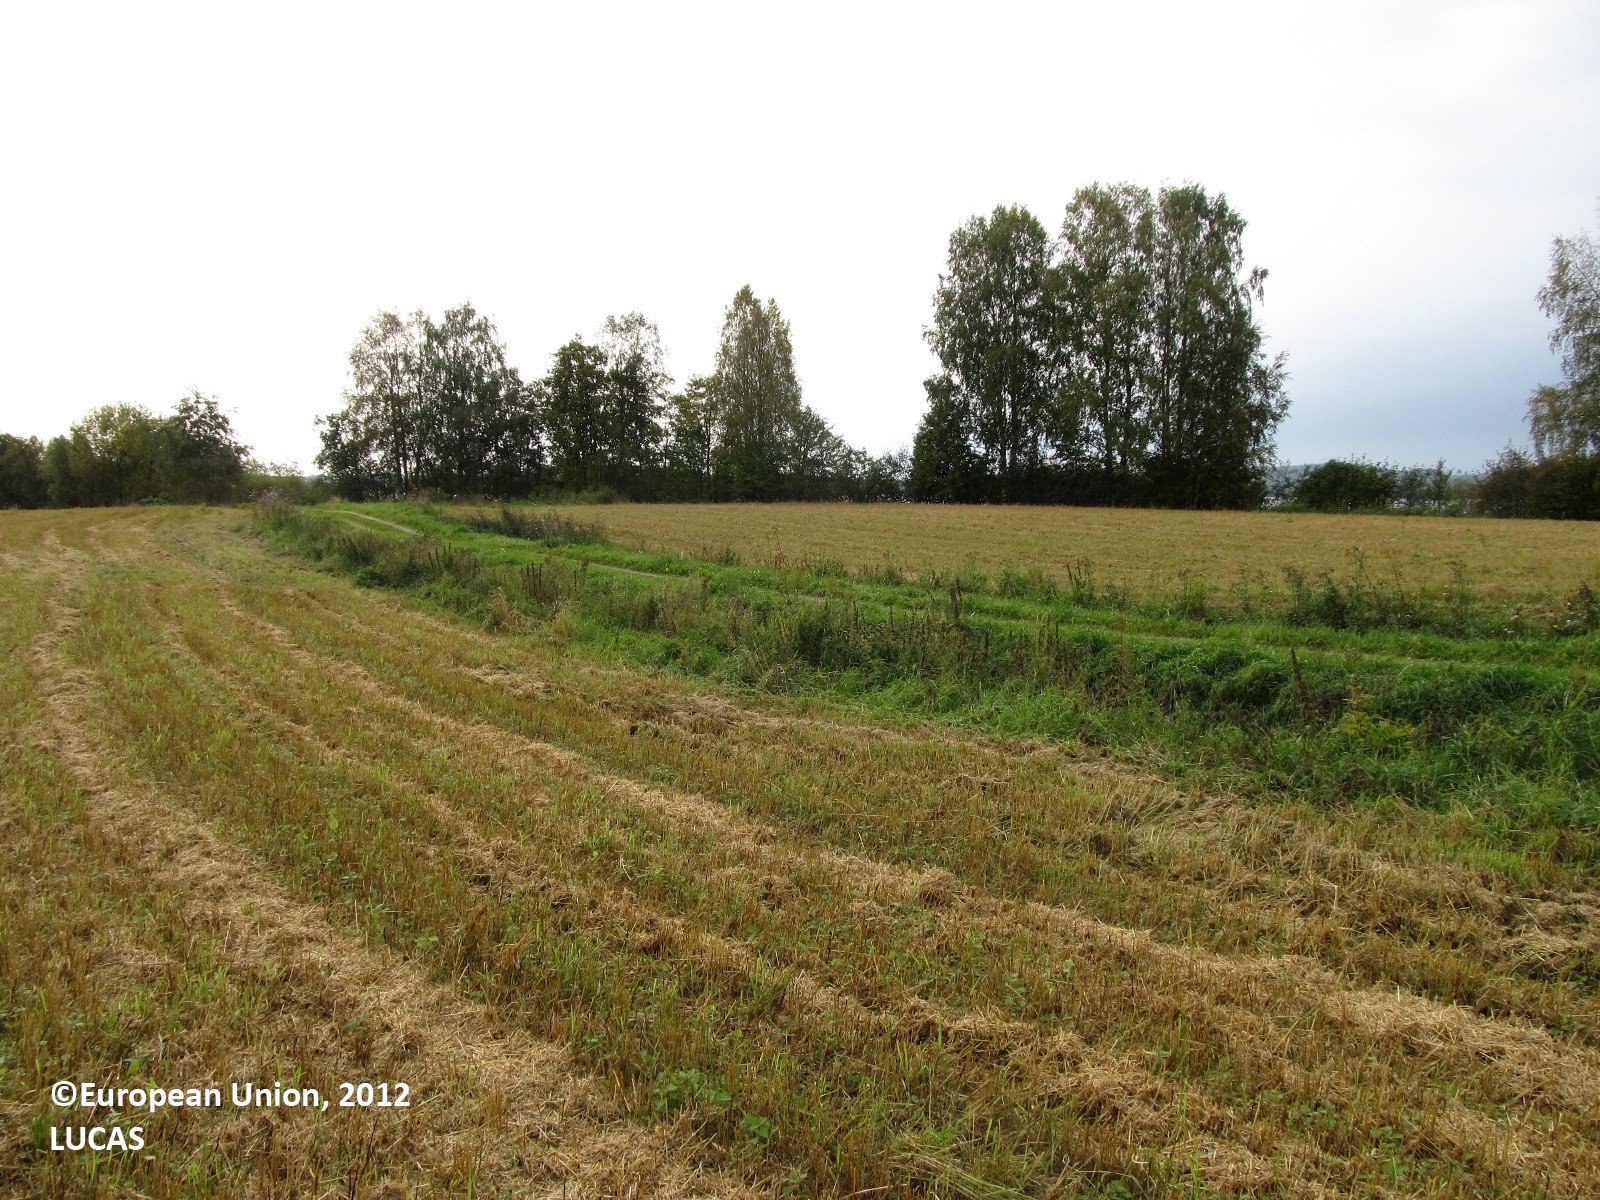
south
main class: Cropland
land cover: Common wheat
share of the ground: 50 - 75 %
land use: Agriculture (excluding fallow land and kitchen gardens)
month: September
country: FI
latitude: 63.0115
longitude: 28.2184
